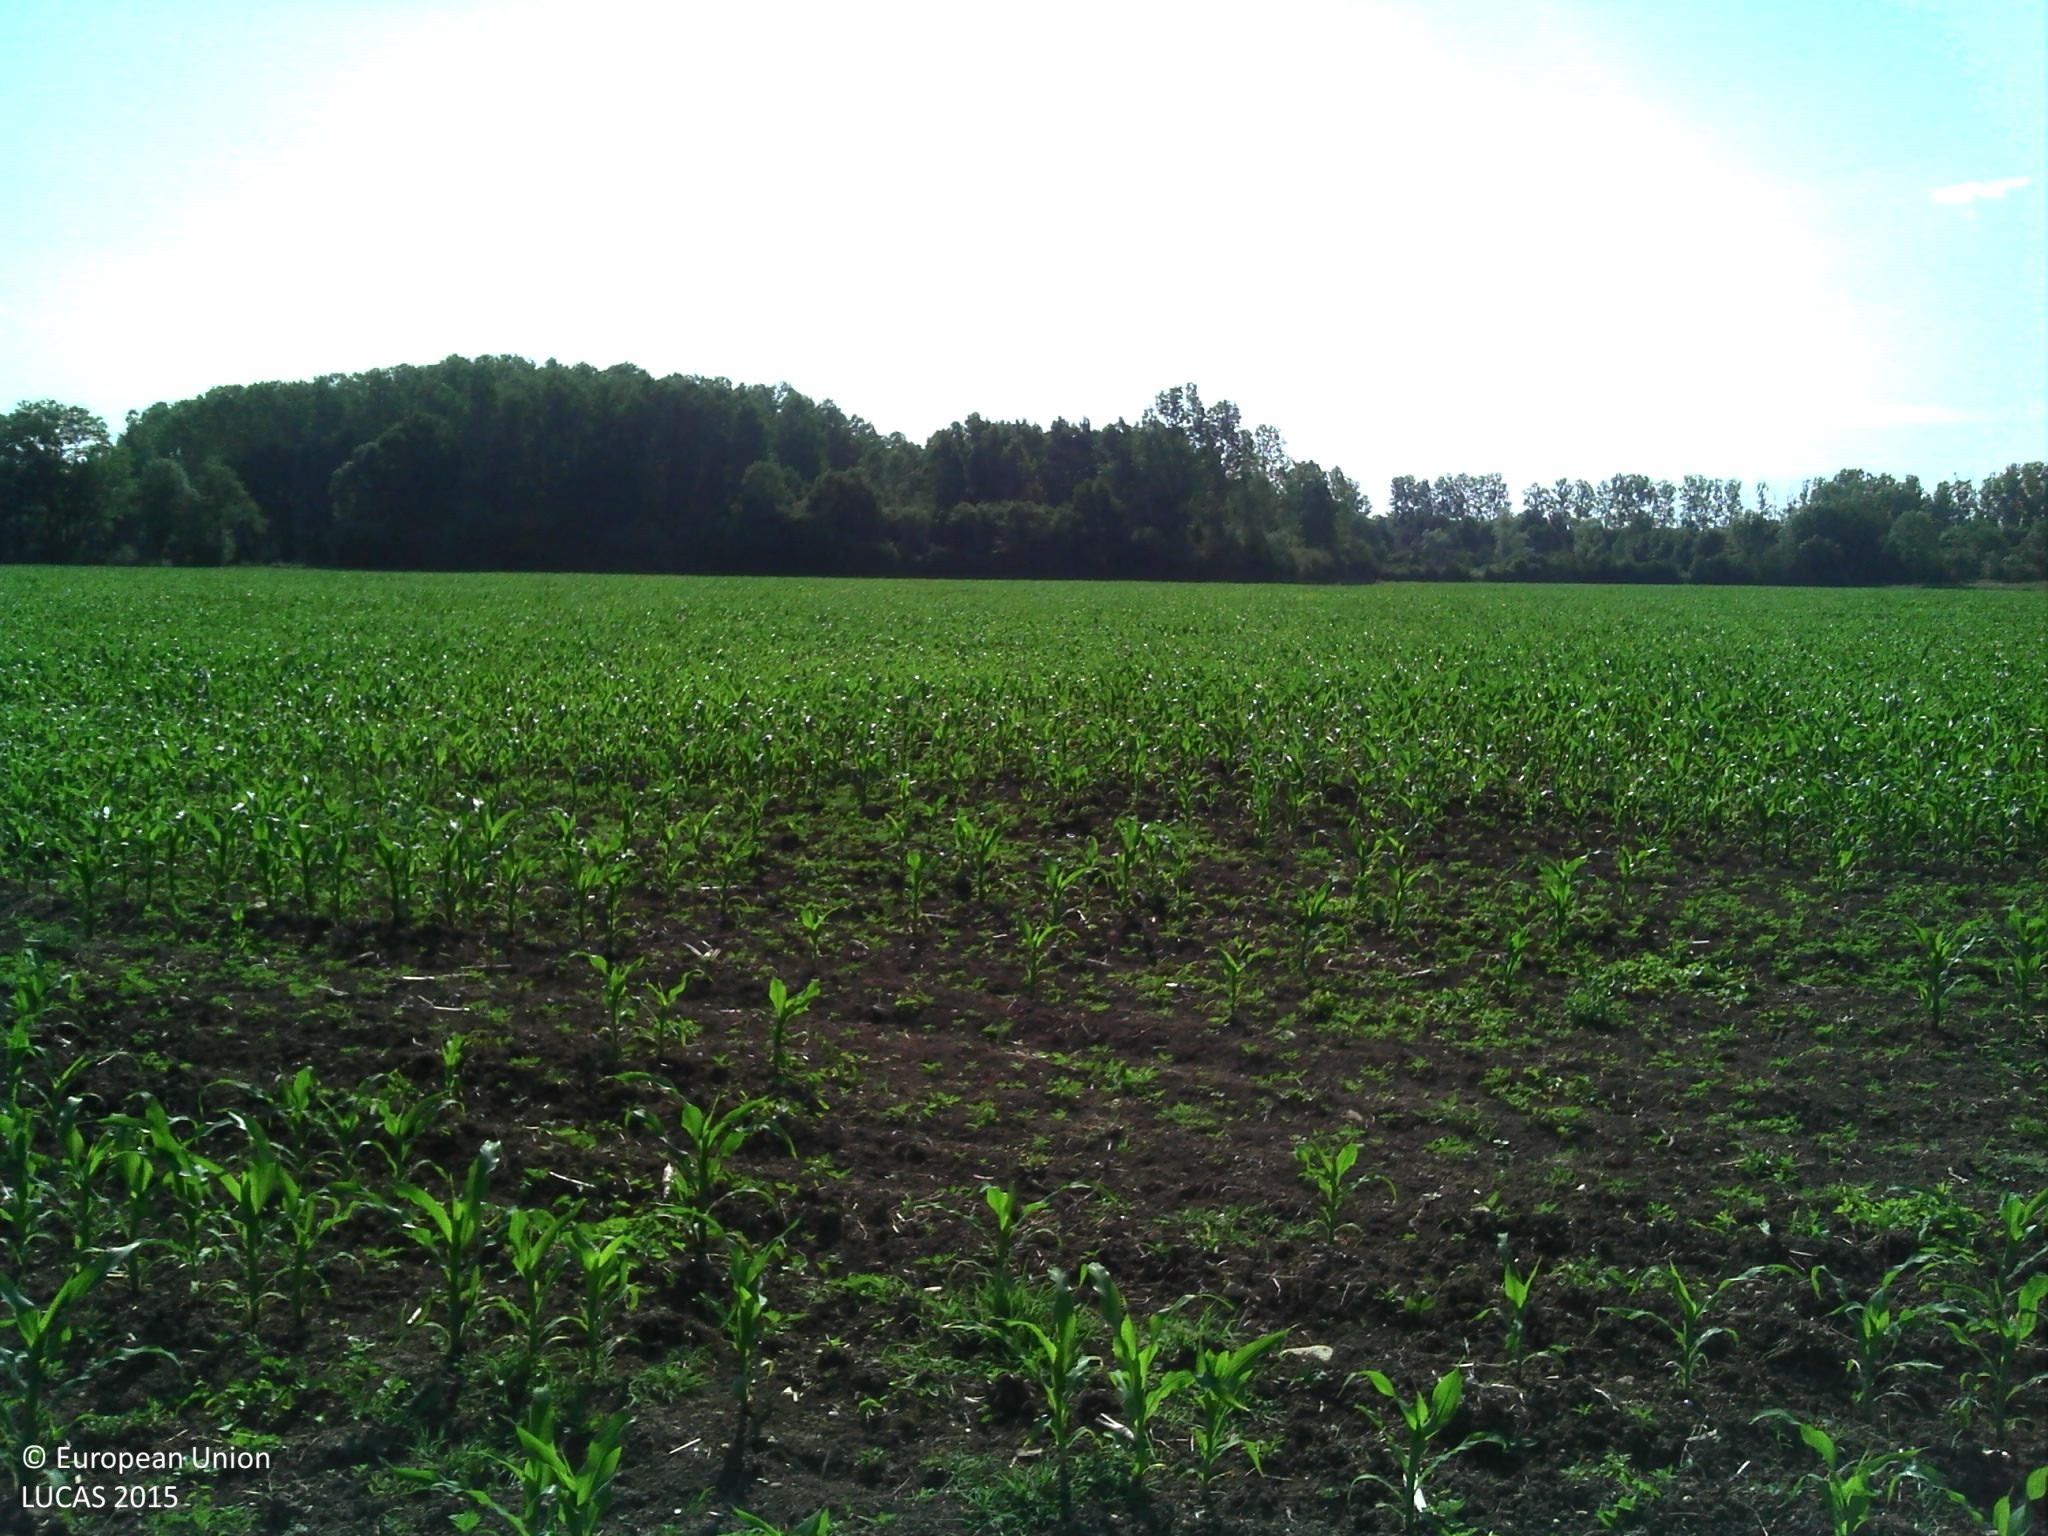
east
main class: Cropland
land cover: Maize
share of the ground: 50 - 75 %
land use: Agriculture (excluding fallow land and kitchen gardens)
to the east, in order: Maize; Ditches and canals; Broadleaved woodland
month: June
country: FR
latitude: 46.7724
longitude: 2.7271
